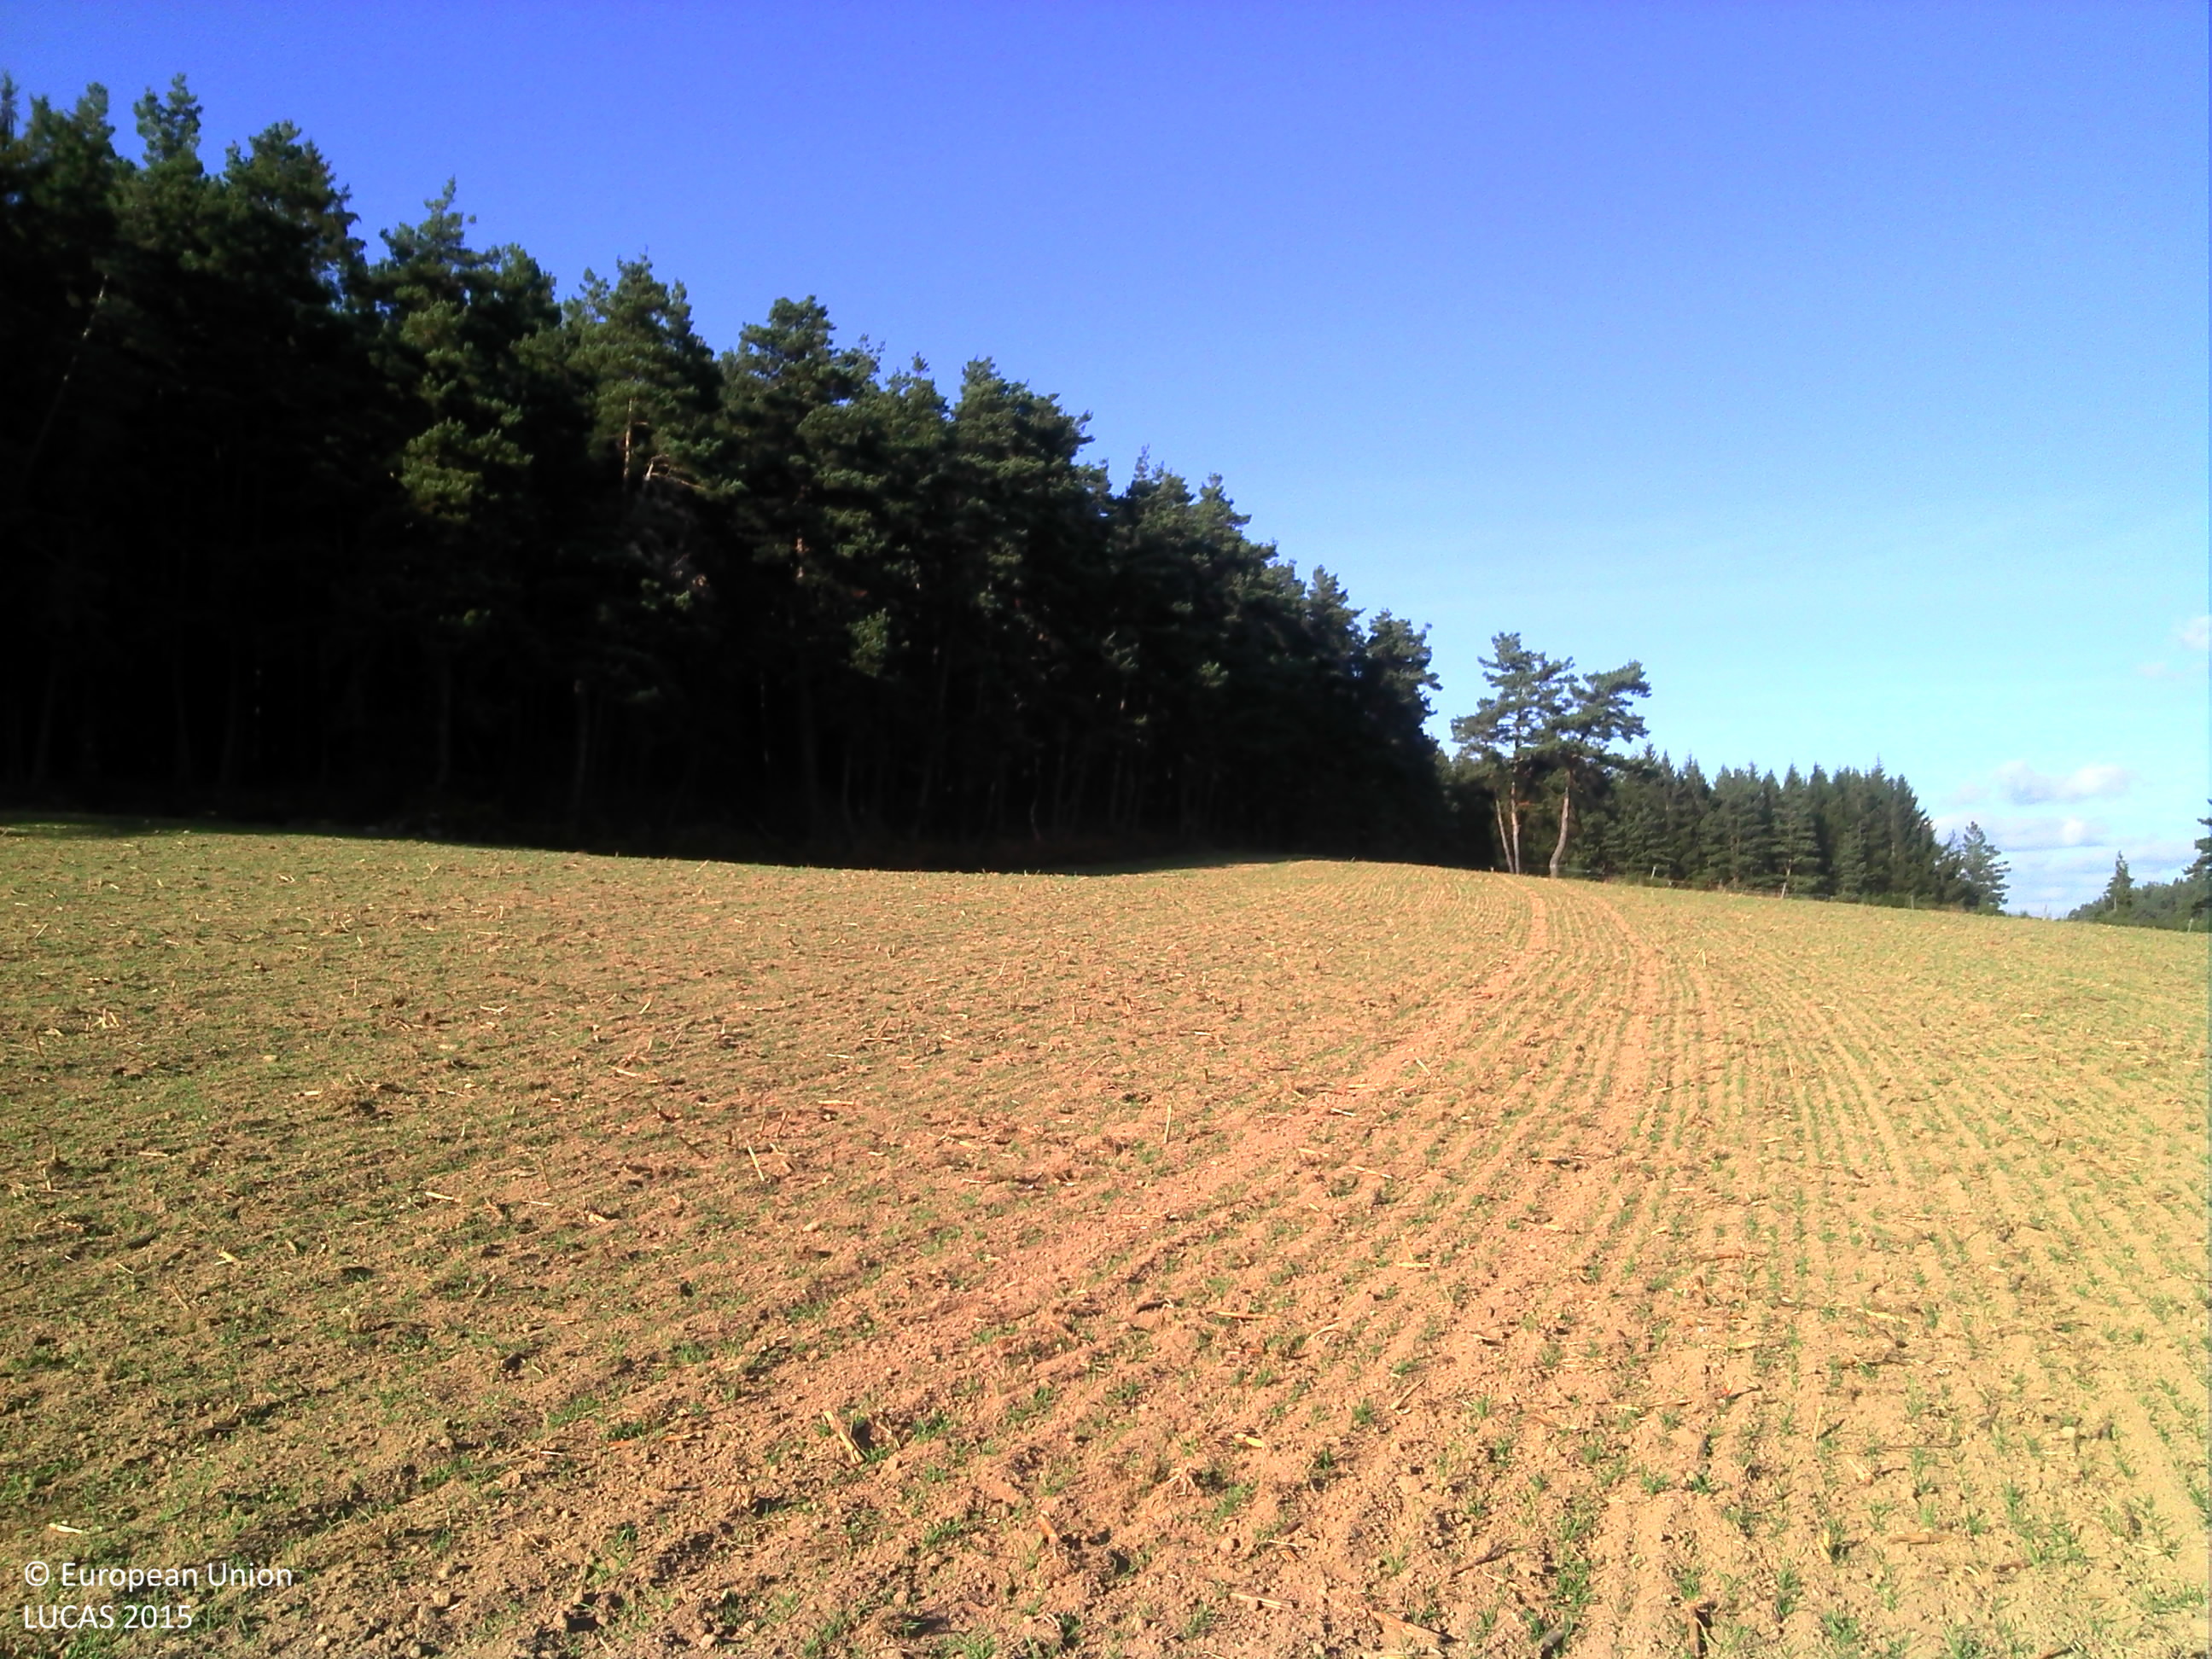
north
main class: Cropland
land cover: Temporary grasslands
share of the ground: 10 - 25 %
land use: Agriculture (excluding fallow land and kitchen gardens)
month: November
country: FR
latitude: 45.2498
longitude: 3.7983
